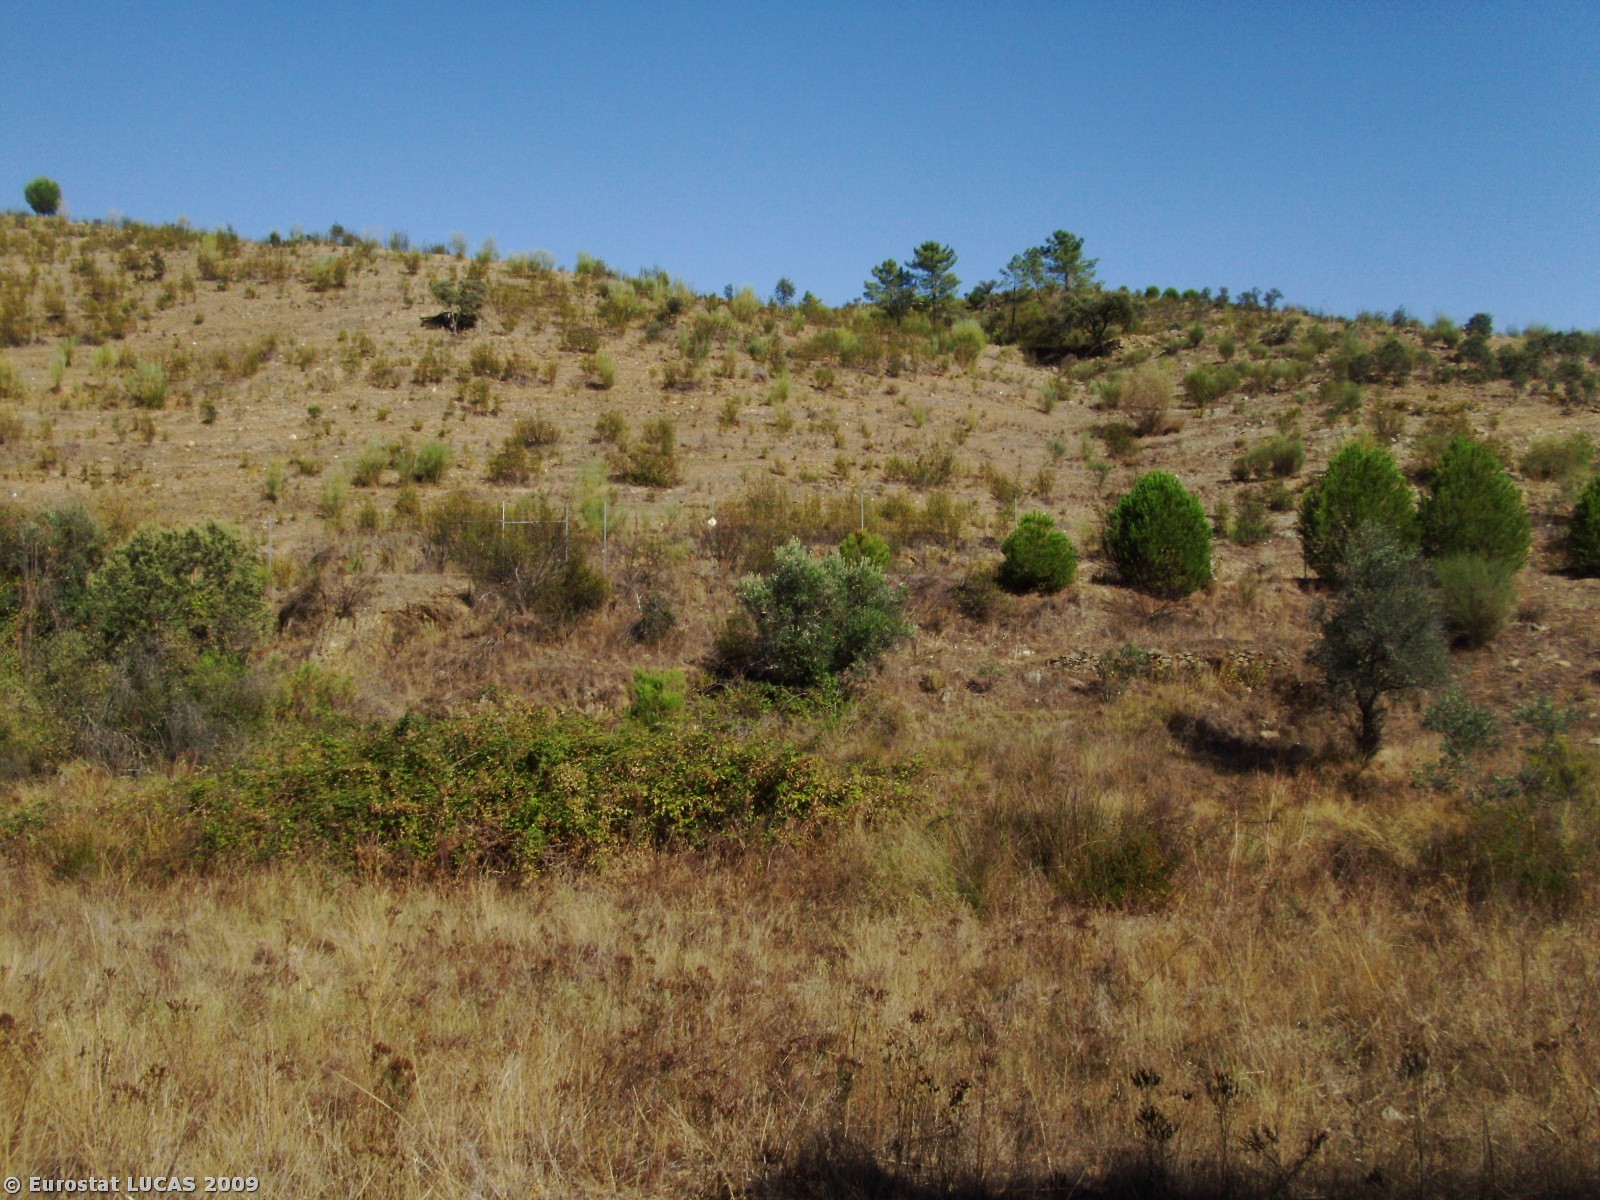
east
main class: Cropland
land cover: Olive groves
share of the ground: 25 - 50 %
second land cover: Spontaneously vegetated surfaces
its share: 50 - 75 %
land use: Agriculture (excluding fallow land and kitchen gardens)
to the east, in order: Olive groves; Spontaneously vegetated surfaces; Rivers and streams; Shrubland with sparse tree cover; Fences; Tracks; Spontaneously vegetated surfaces; Broadleaved woodland; Tracks; Broadleaved woodland; Rivers and streams; Broadleaved woodland
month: May
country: PT
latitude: 39.7514
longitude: -7.4995
